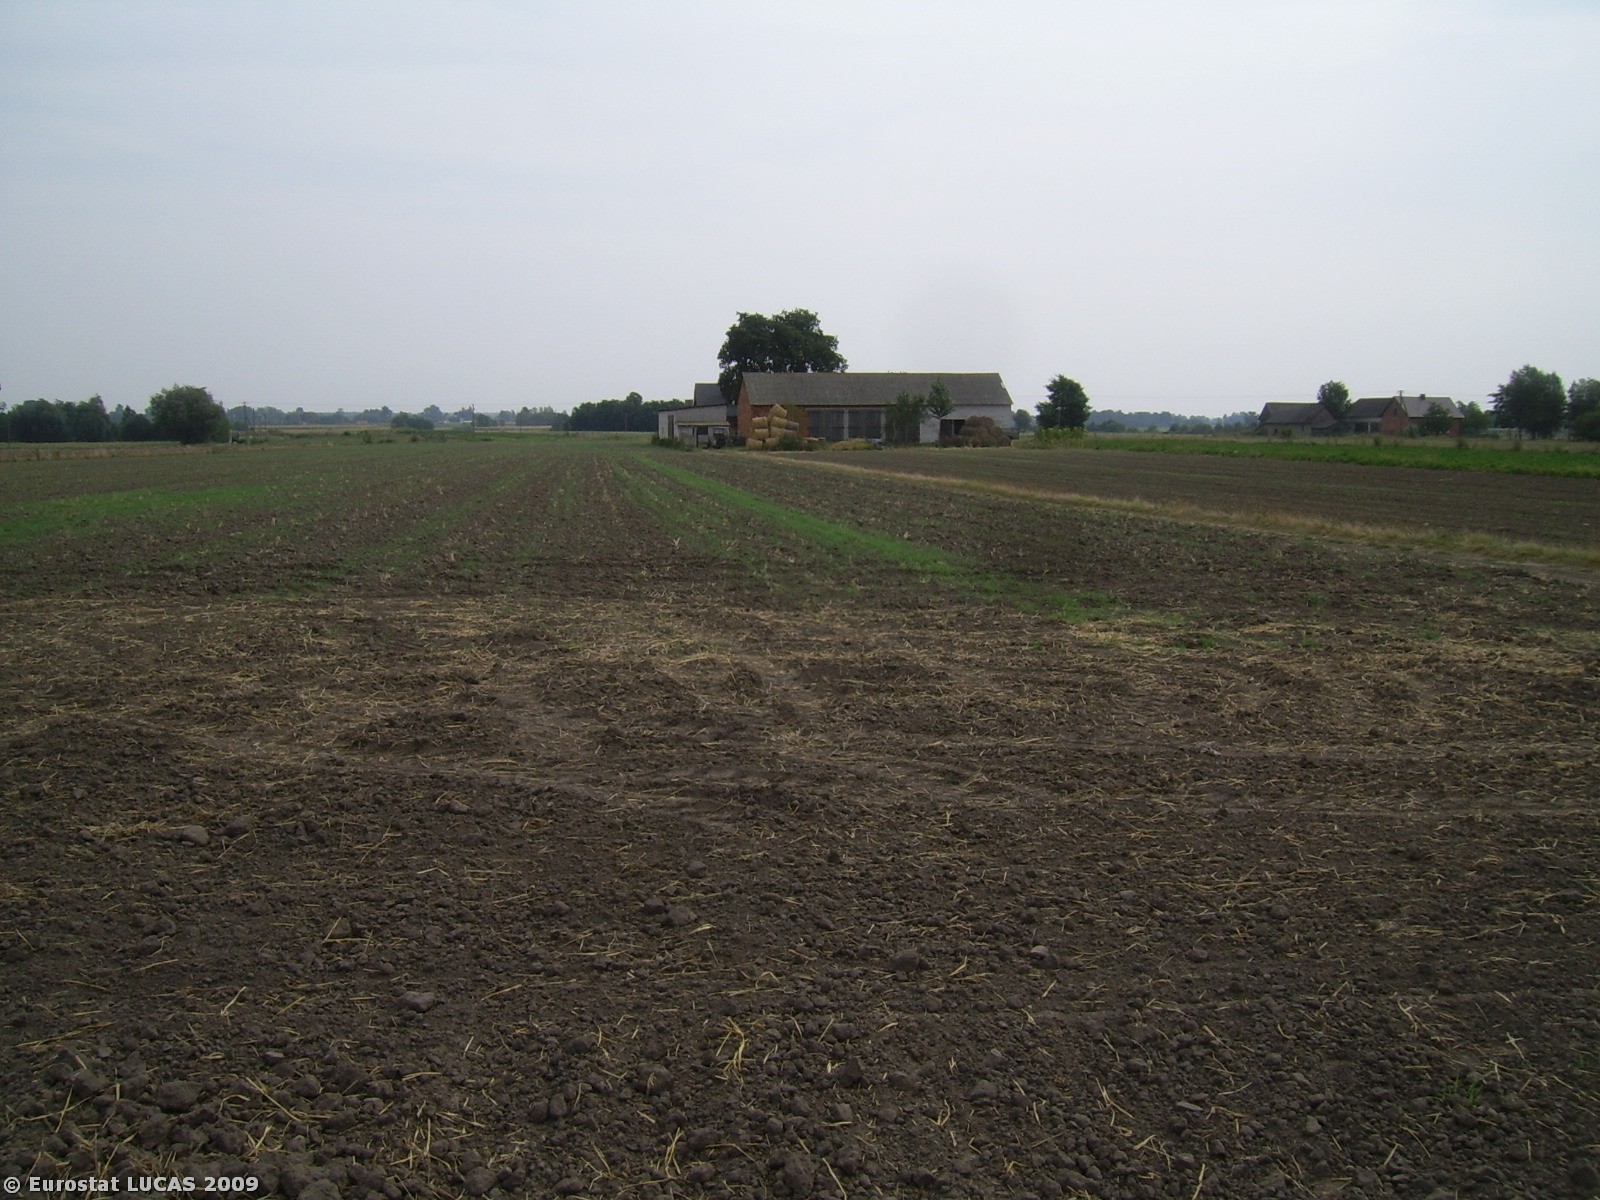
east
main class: Cropland
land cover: Mixed cereals for fodder
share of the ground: < 10 %
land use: Agriculture (excluding fallow land and kitchen gardens)
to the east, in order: Mixed cereals for fodder; Common wheat; Artificial constructions in urban areas; Grassland without tree/shrub cover
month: August
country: PL
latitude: 51.7316
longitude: 18.4604
